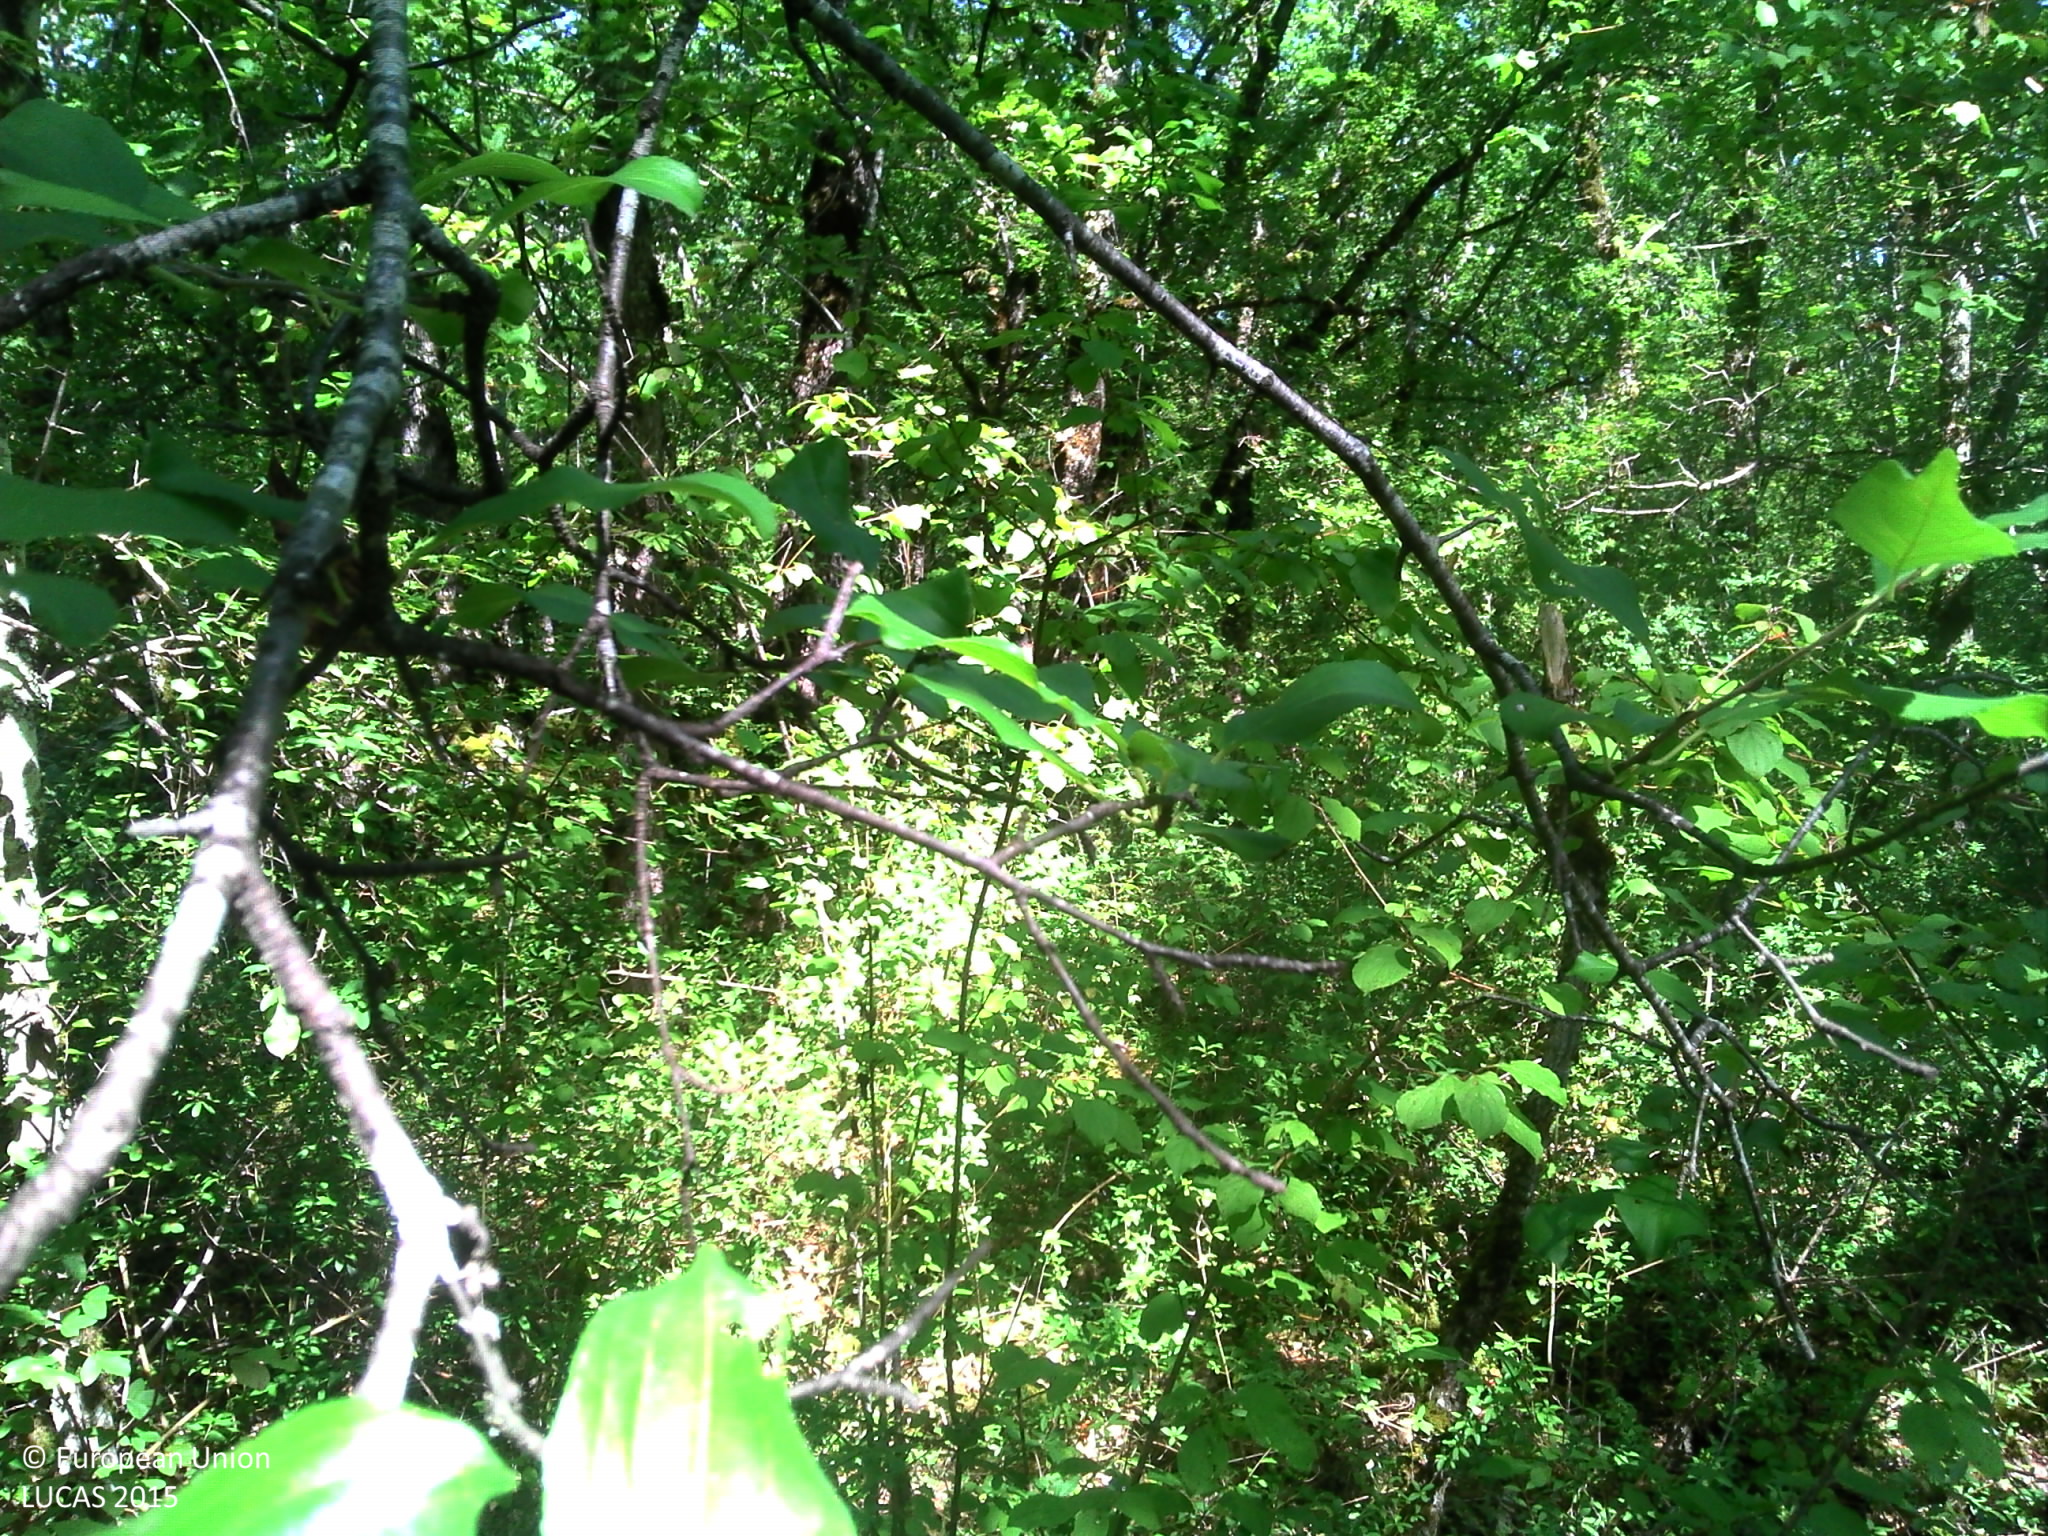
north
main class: Woodland
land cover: Broadleaved woodland
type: thermophilous deciduous forest
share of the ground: > 75 %
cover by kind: broadleaved forest trees 60 %, shrubs 25 %, herbaceous plants 10 %, lichens and mosses 5 %
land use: Forestry
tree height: > 5 m
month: August
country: FR
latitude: 44.2848
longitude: 1.6418
